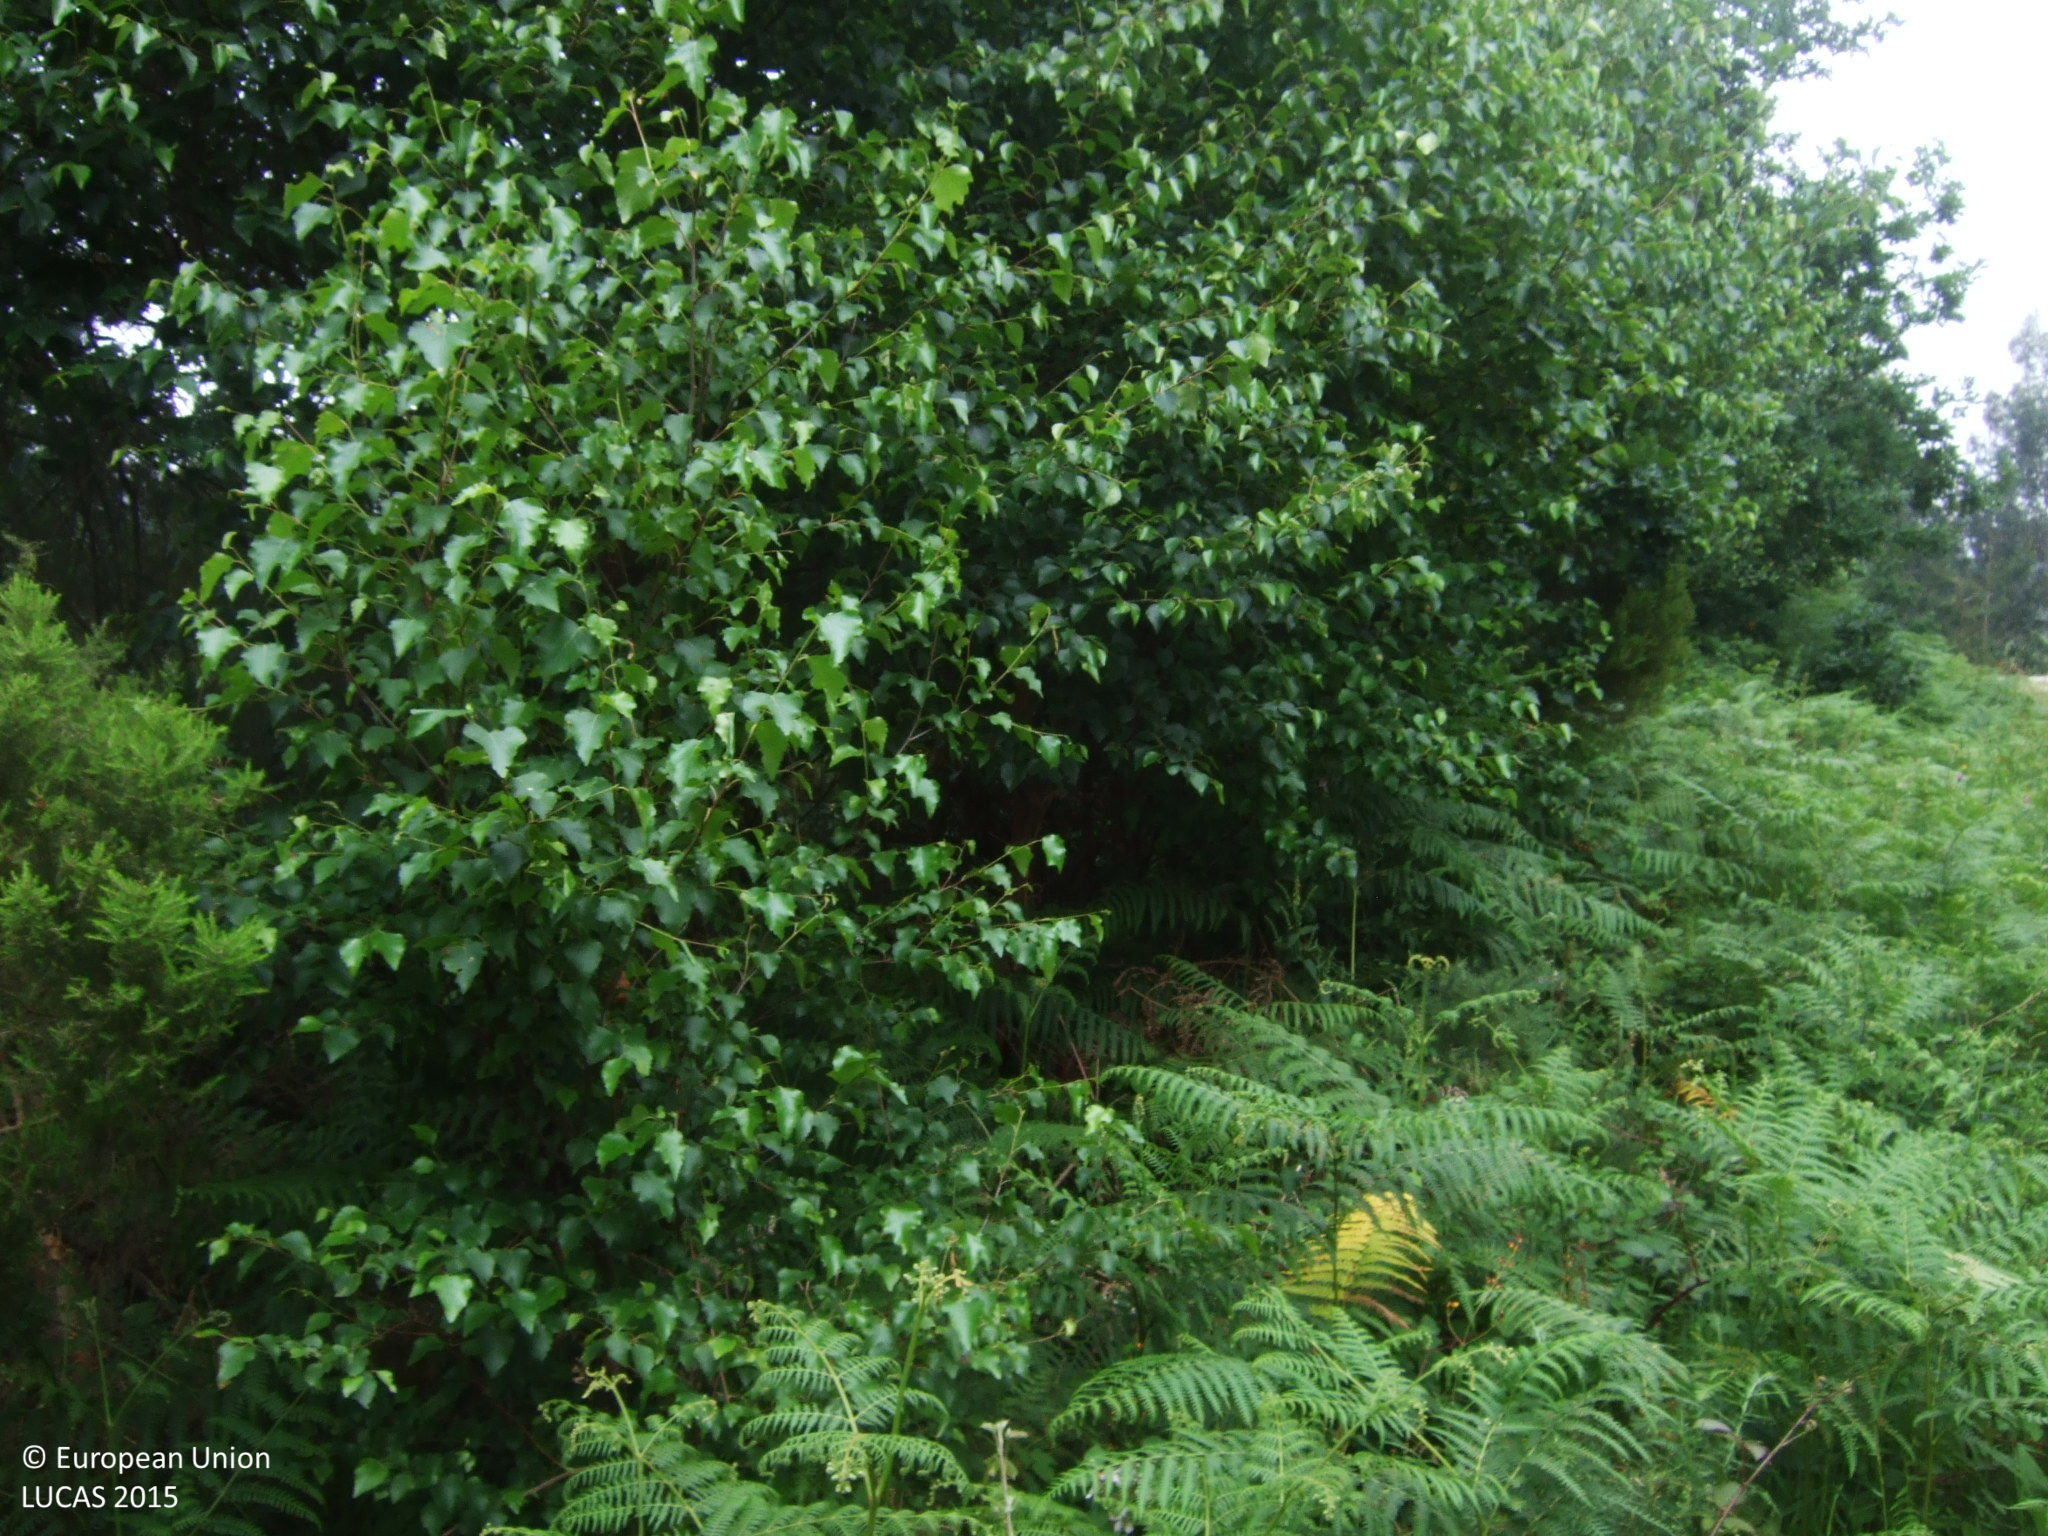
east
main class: Woodland
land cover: Broadleaved woodland
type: acidophilous oak and oak-birch forest
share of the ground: 50 - 75 %
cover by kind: broadleaved forest trees 60 %, shrubs 40 %
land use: Forestry
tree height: > 5 m
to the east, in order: Broadleaved woodland; Electric lines; Broadleaved woodland; Tracks; Broadleaved woodland
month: June
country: ES
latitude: 43.6155
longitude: -7.5432
